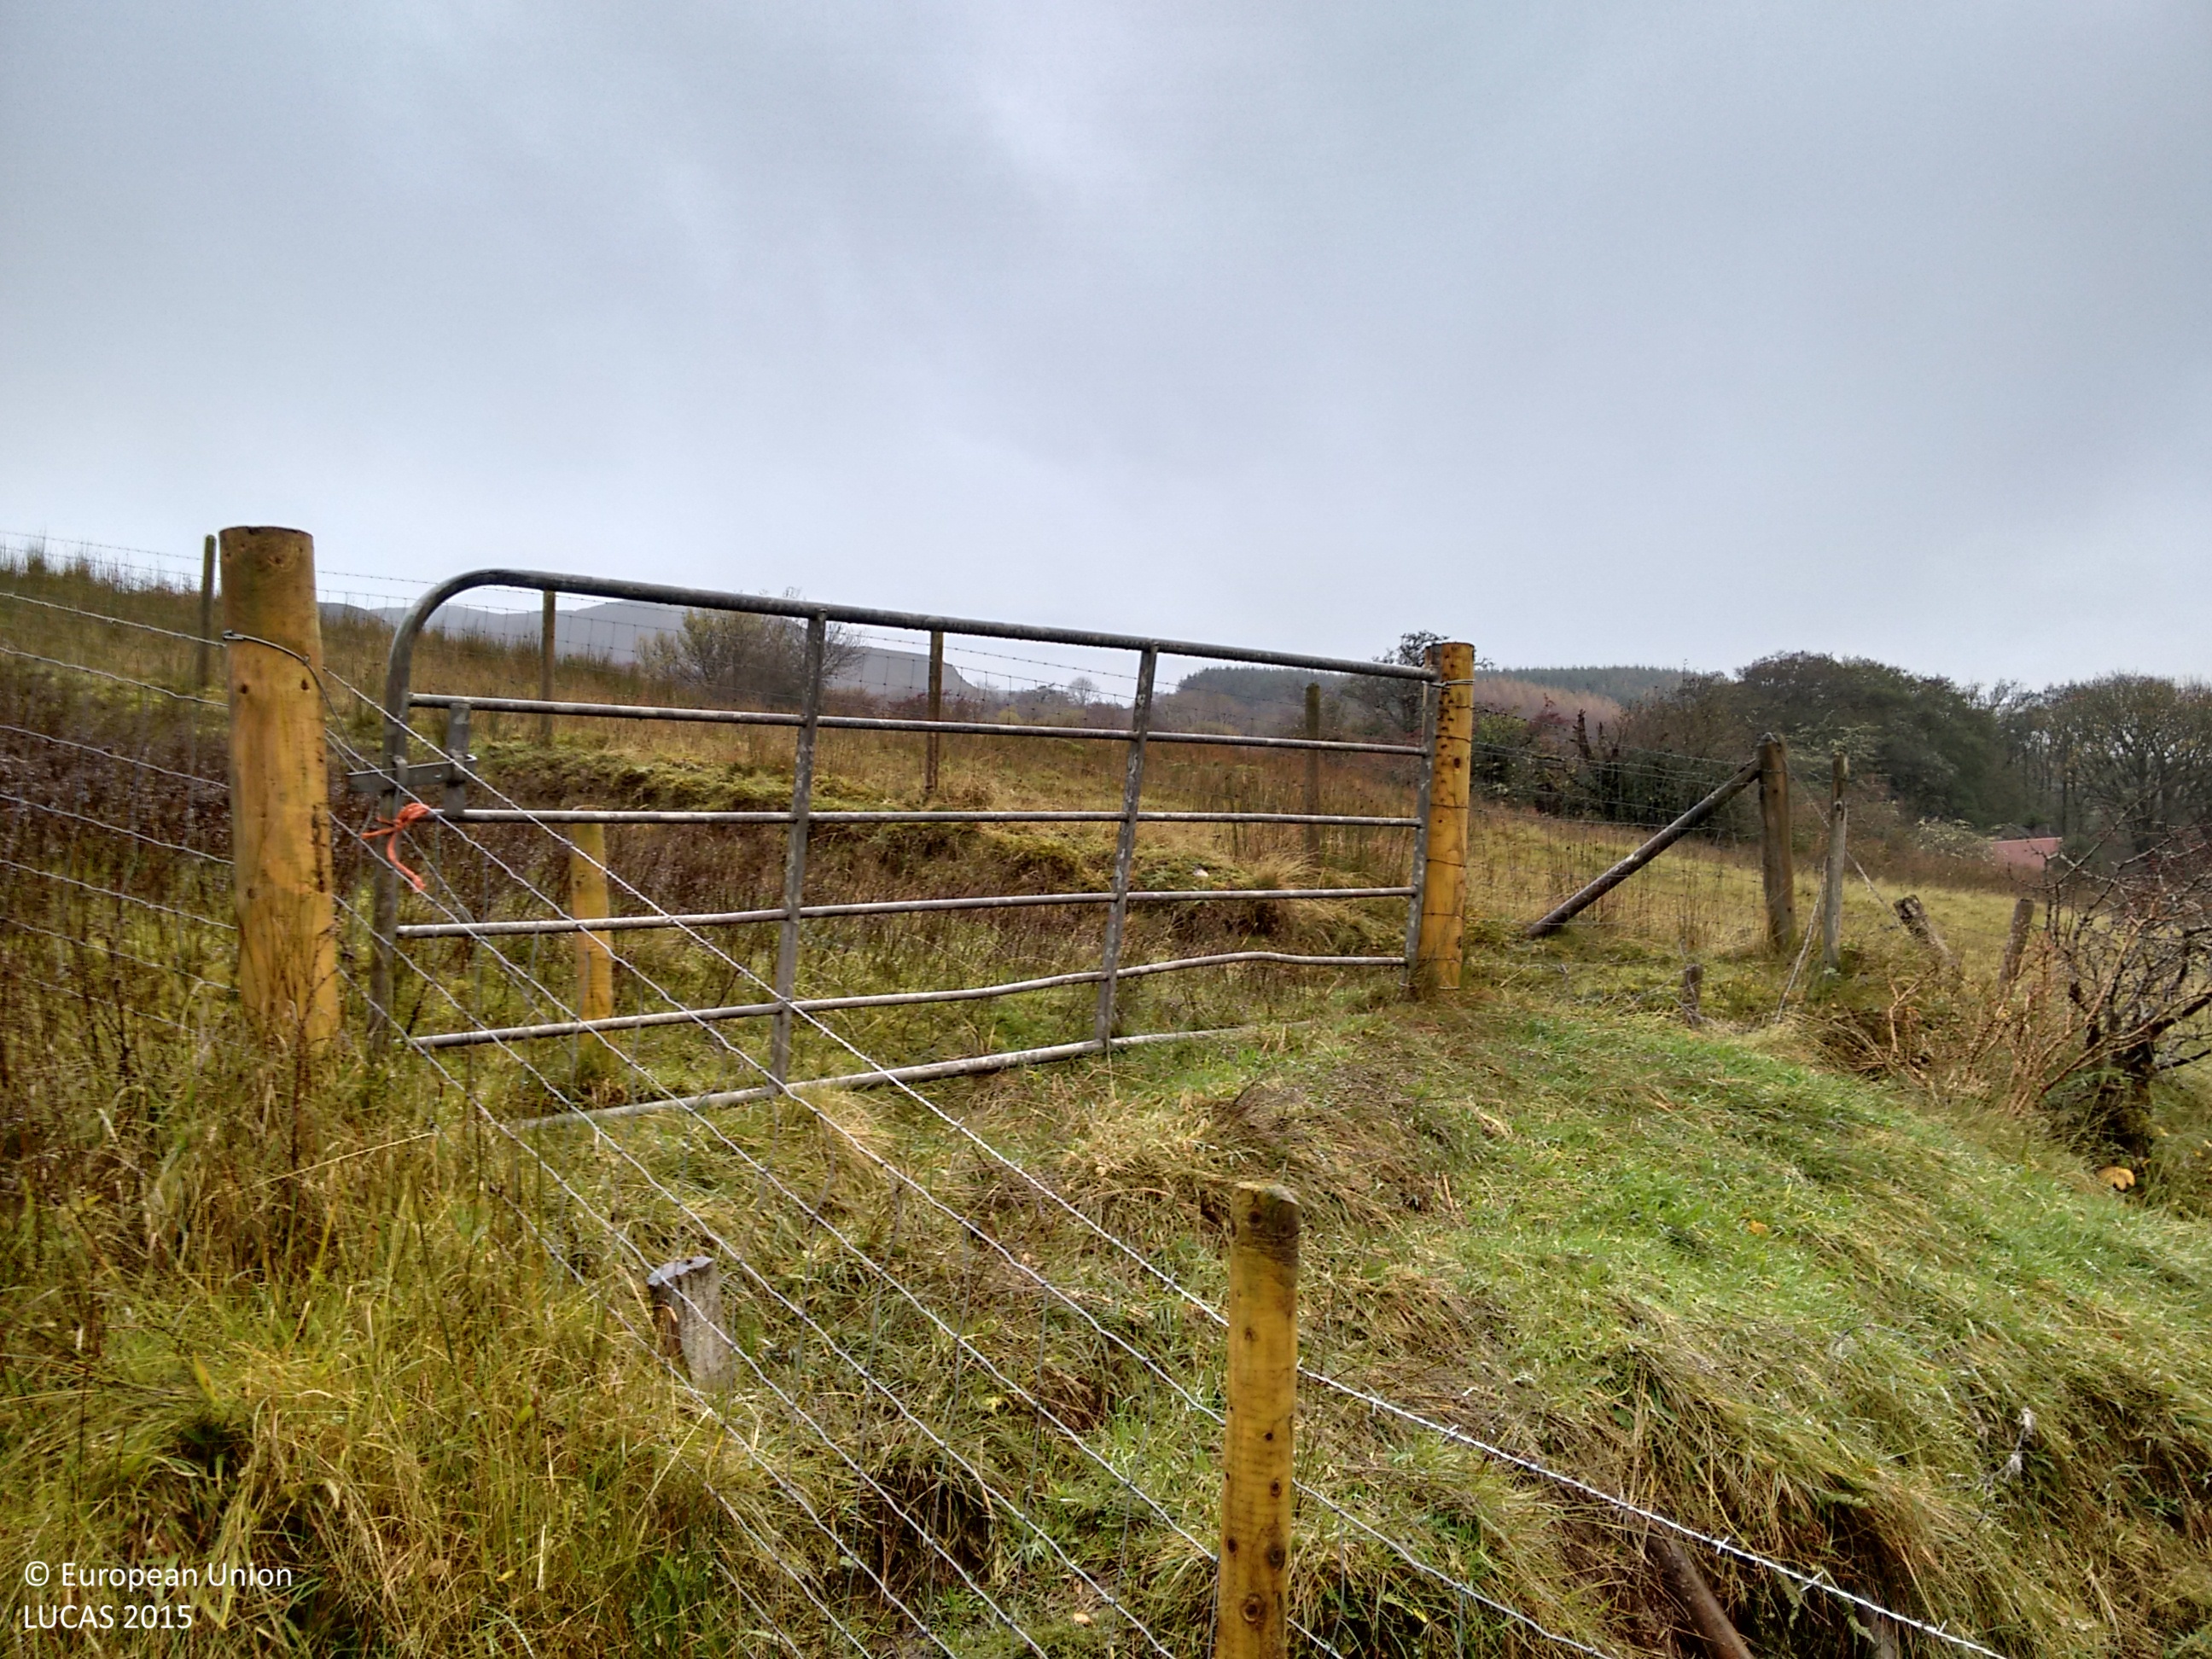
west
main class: Grassland
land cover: Grassland without tree/shrub cover
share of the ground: > 75 %
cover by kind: herbaceous plants 100 %
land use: Agriculture (excluding fallow land and kitchen gardens)
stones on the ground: < 10 %
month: November
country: IE
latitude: 54.4123
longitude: -8.1605
